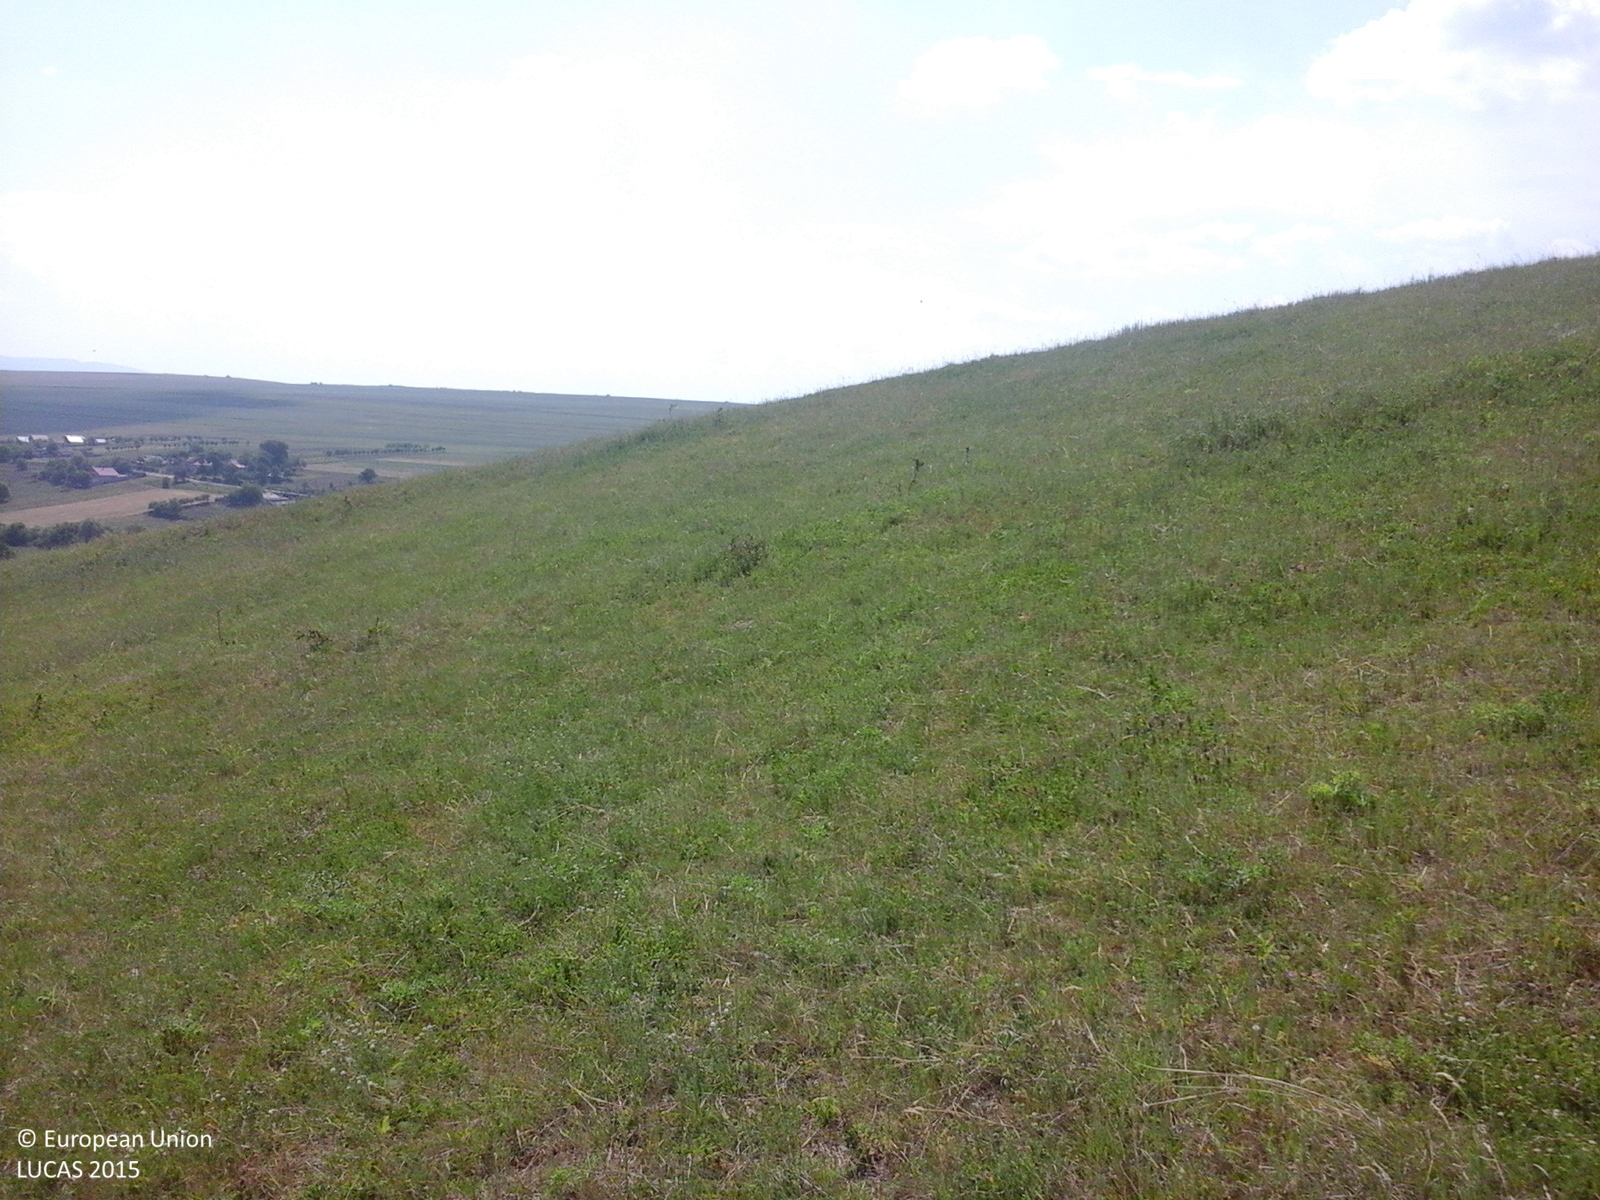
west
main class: Grassland
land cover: Grassland without tree/shrub cover
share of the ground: > 75 %
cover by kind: herbaceous plants 100 %
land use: Agriculture (excluding fallow land and kitchen gardens)
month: June
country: RO
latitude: 46.4273
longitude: 27.1331
